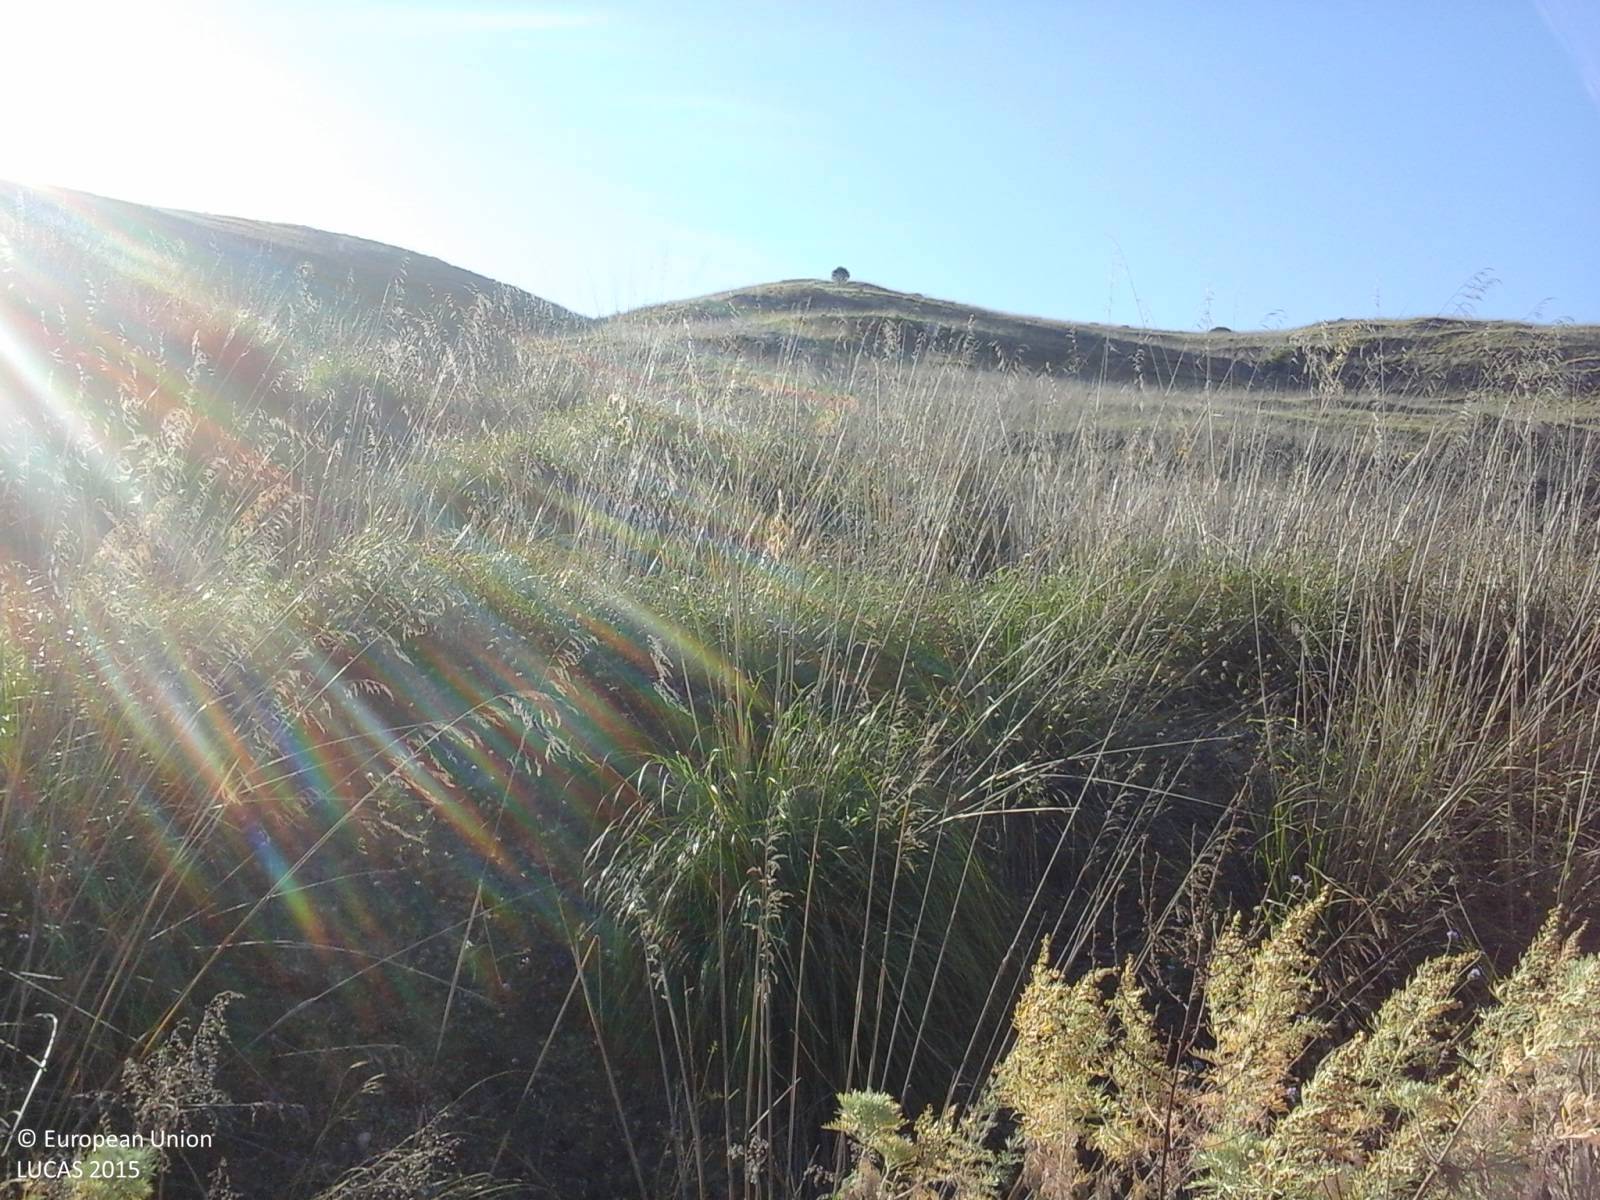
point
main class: Shrubland
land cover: Shrubland without tree cover
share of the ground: > 75 %
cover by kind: shrubs 85 %, herbaceous plants 15 %
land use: Semi-natural and natural areas not in use
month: June
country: IT
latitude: 37.9561
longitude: 12.9491
